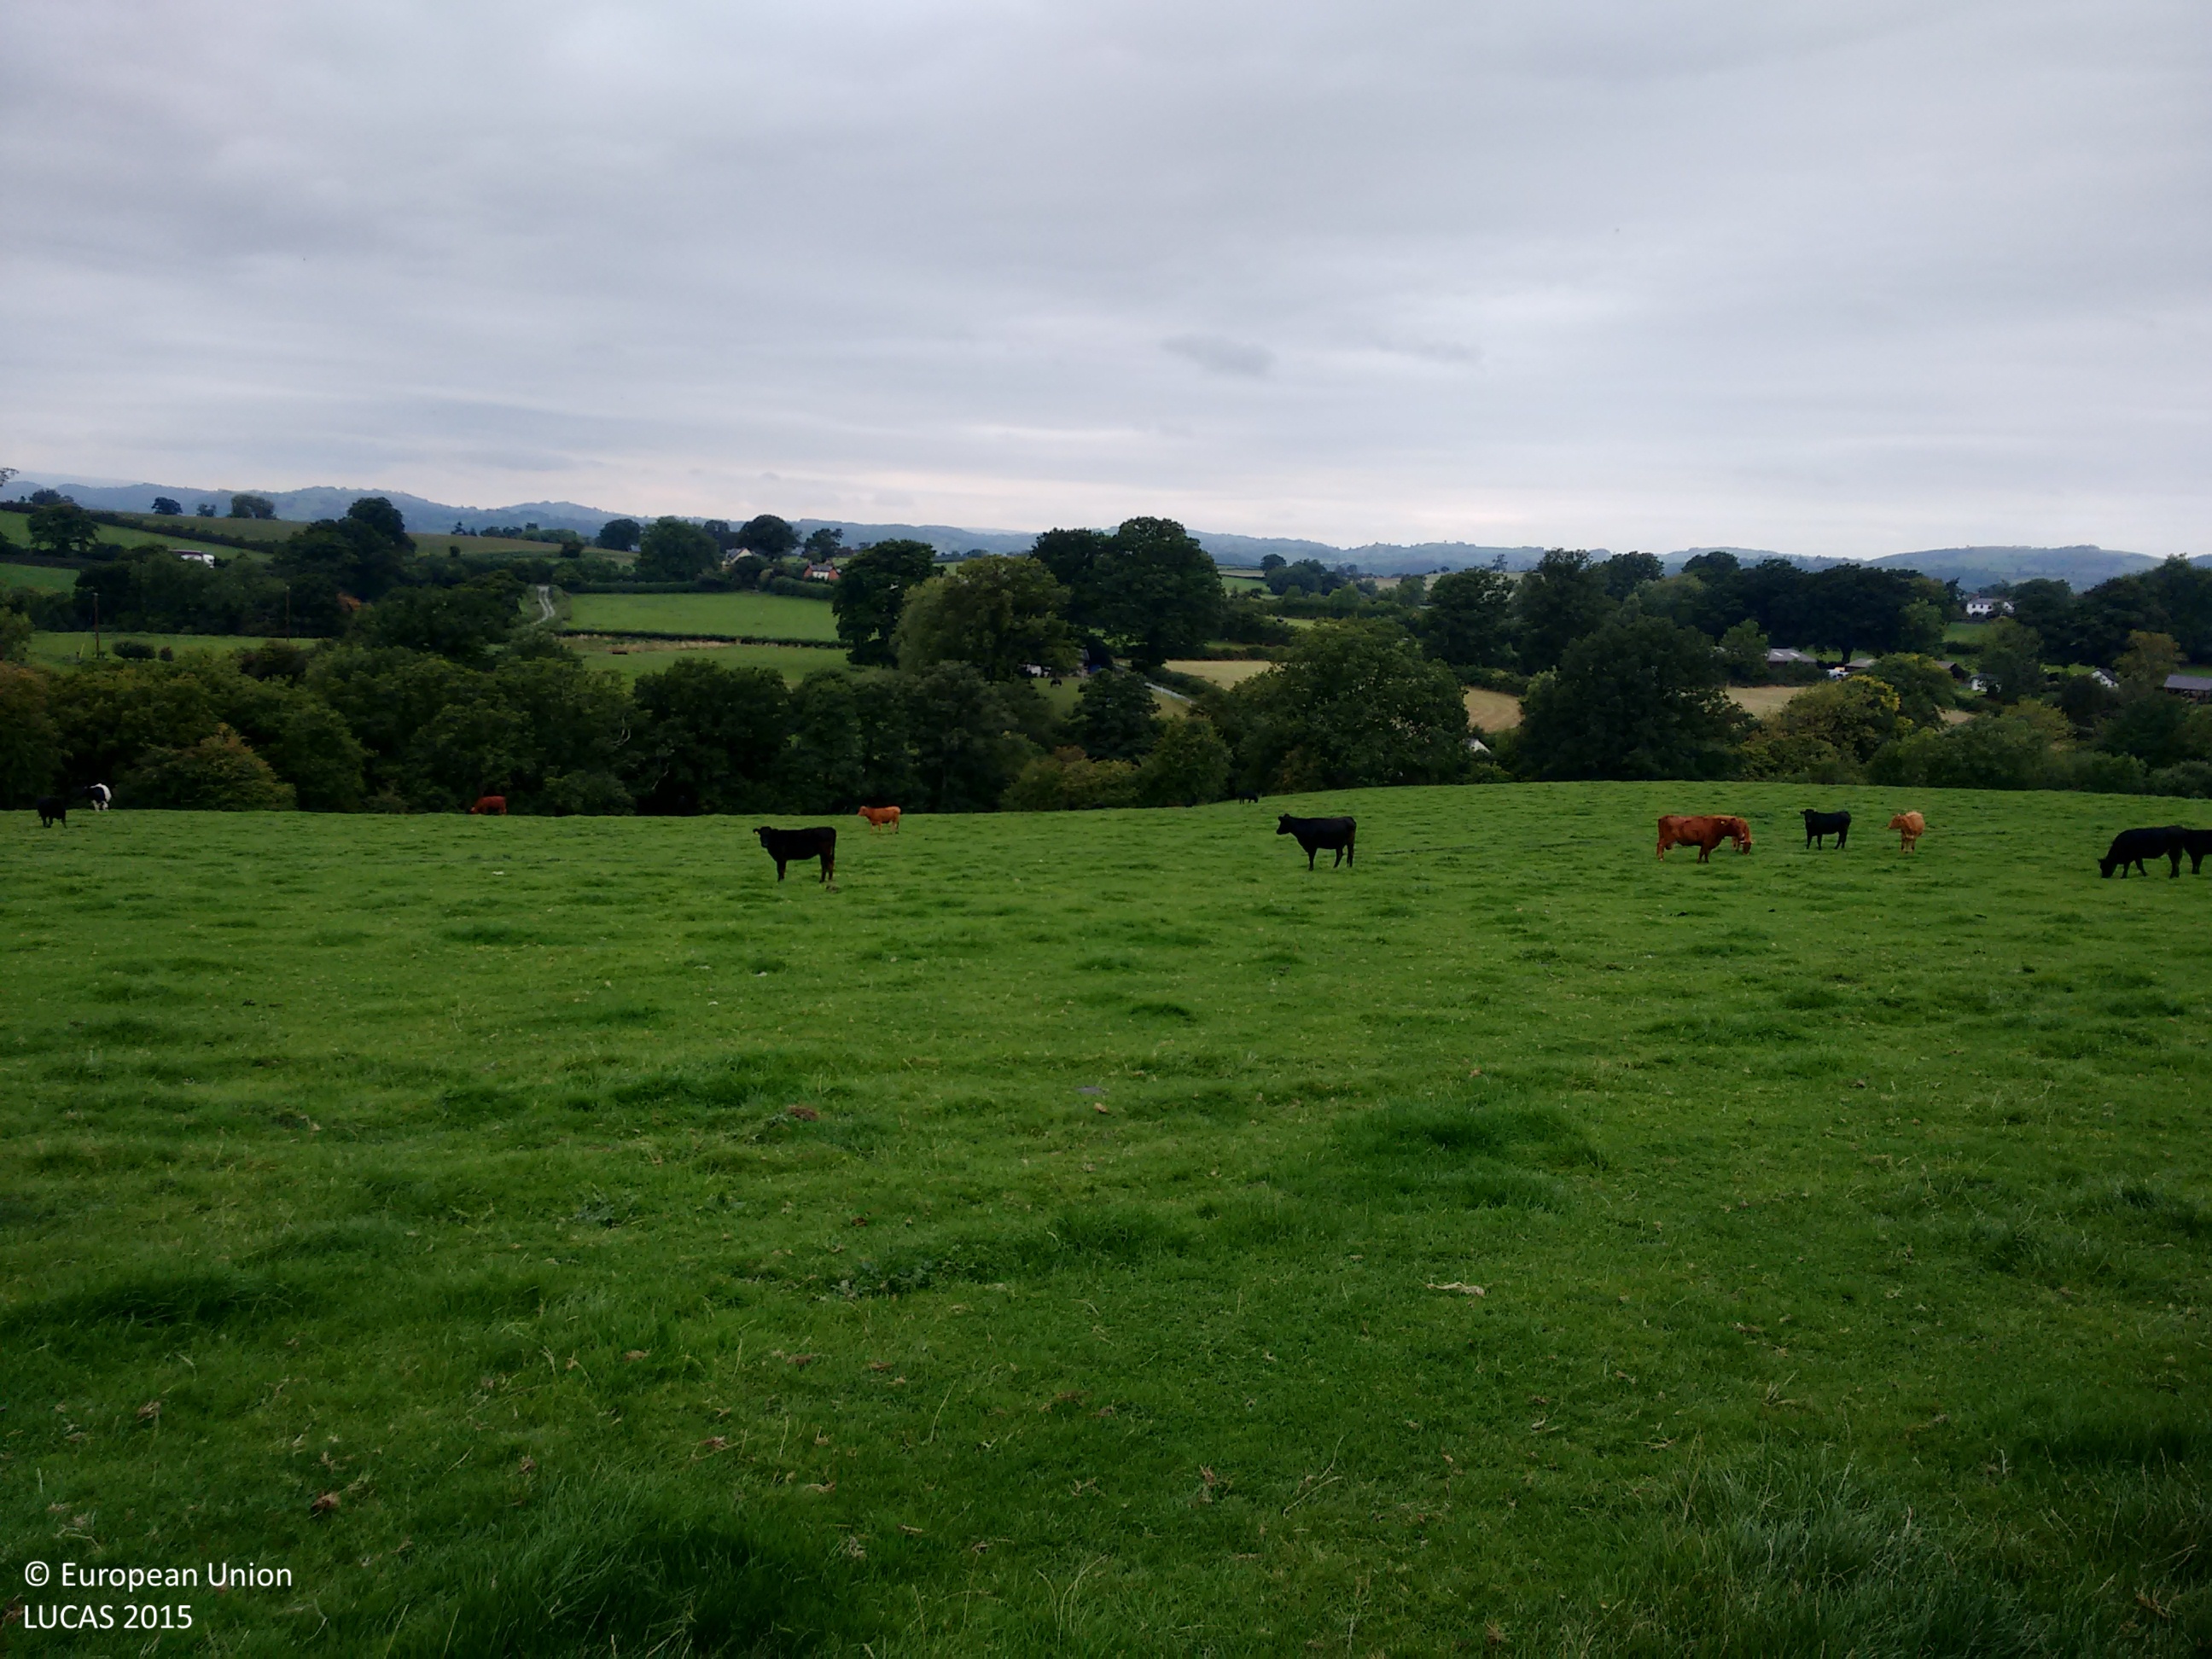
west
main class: Grassland
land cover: Grassland without tree/shrub cover
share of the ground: > 75 %
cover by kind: herbaceous plants 100 %
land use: Agriculture (excluding fallow land and kitchen gardens)
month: September
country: GB
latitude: 52.6114
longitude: -3.1174
